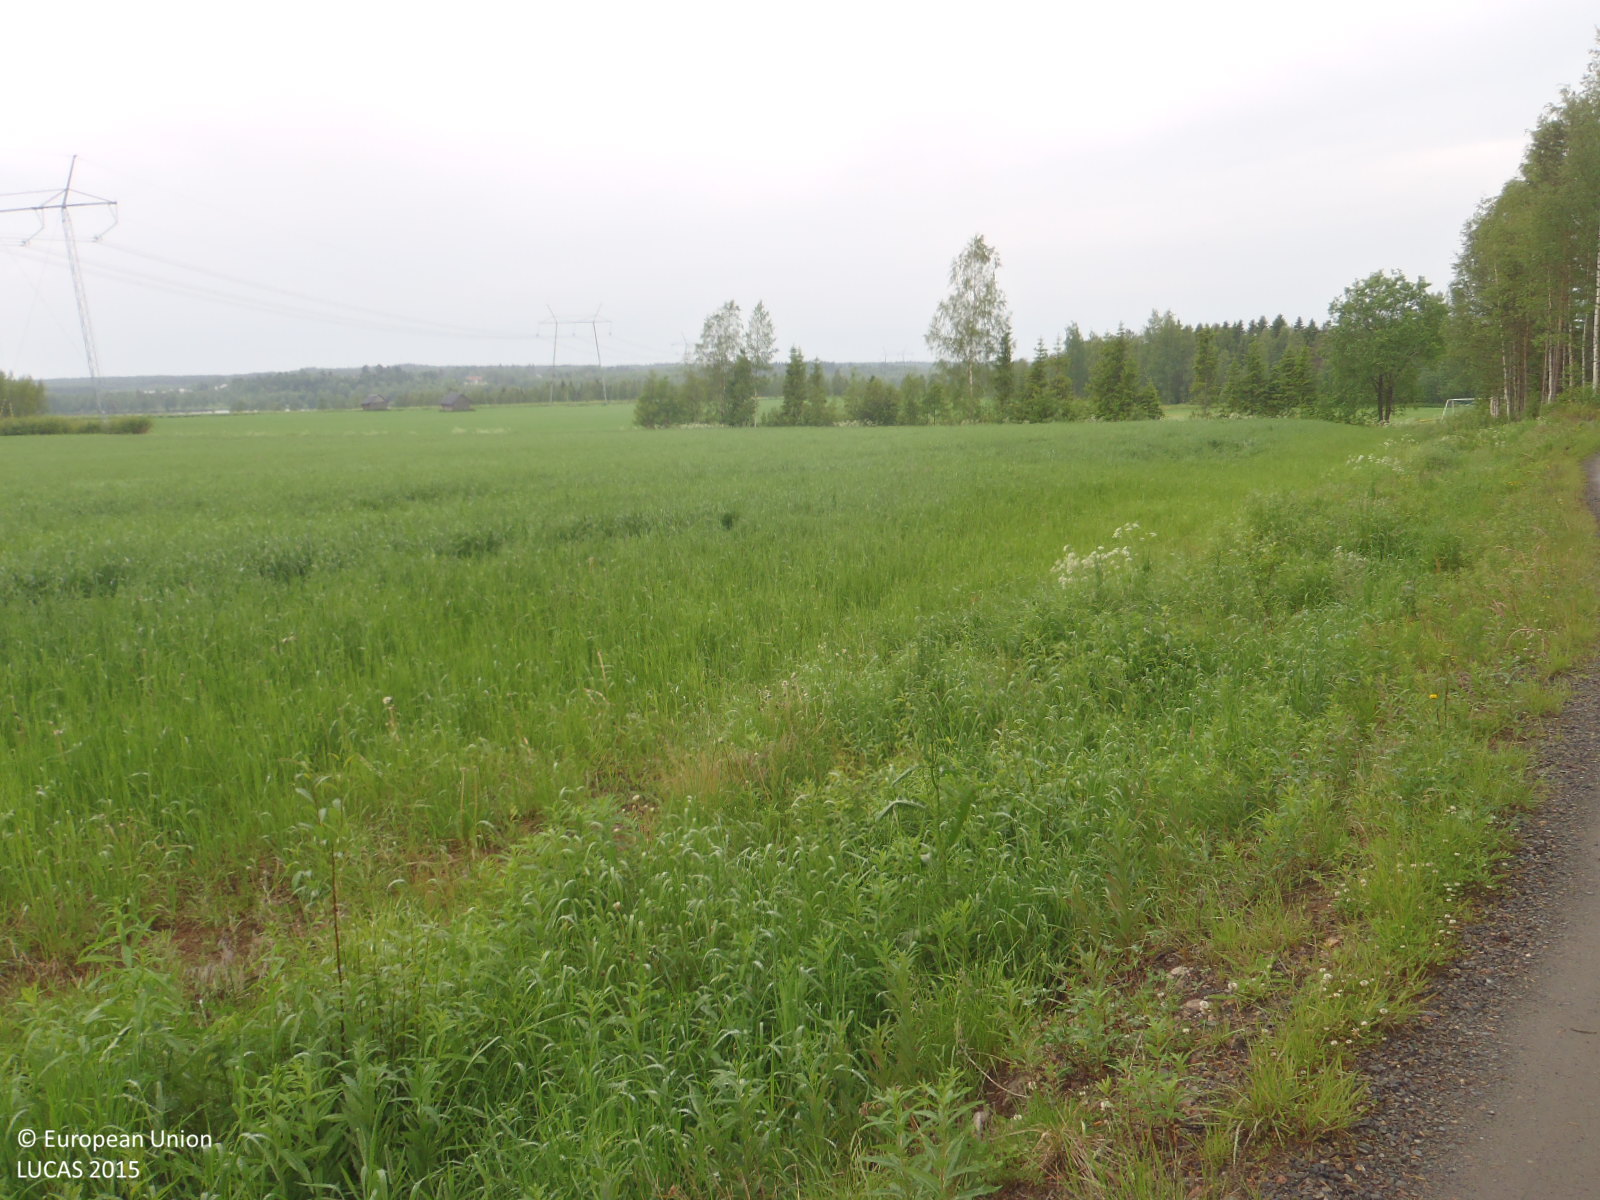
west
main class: Cropland
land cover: Temporary grasslands
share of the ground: > 75 %
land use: Agriculture (excluding fallow land and kitchen gardens)
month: June
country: FI
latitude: 64.9095
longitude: 25.8385
